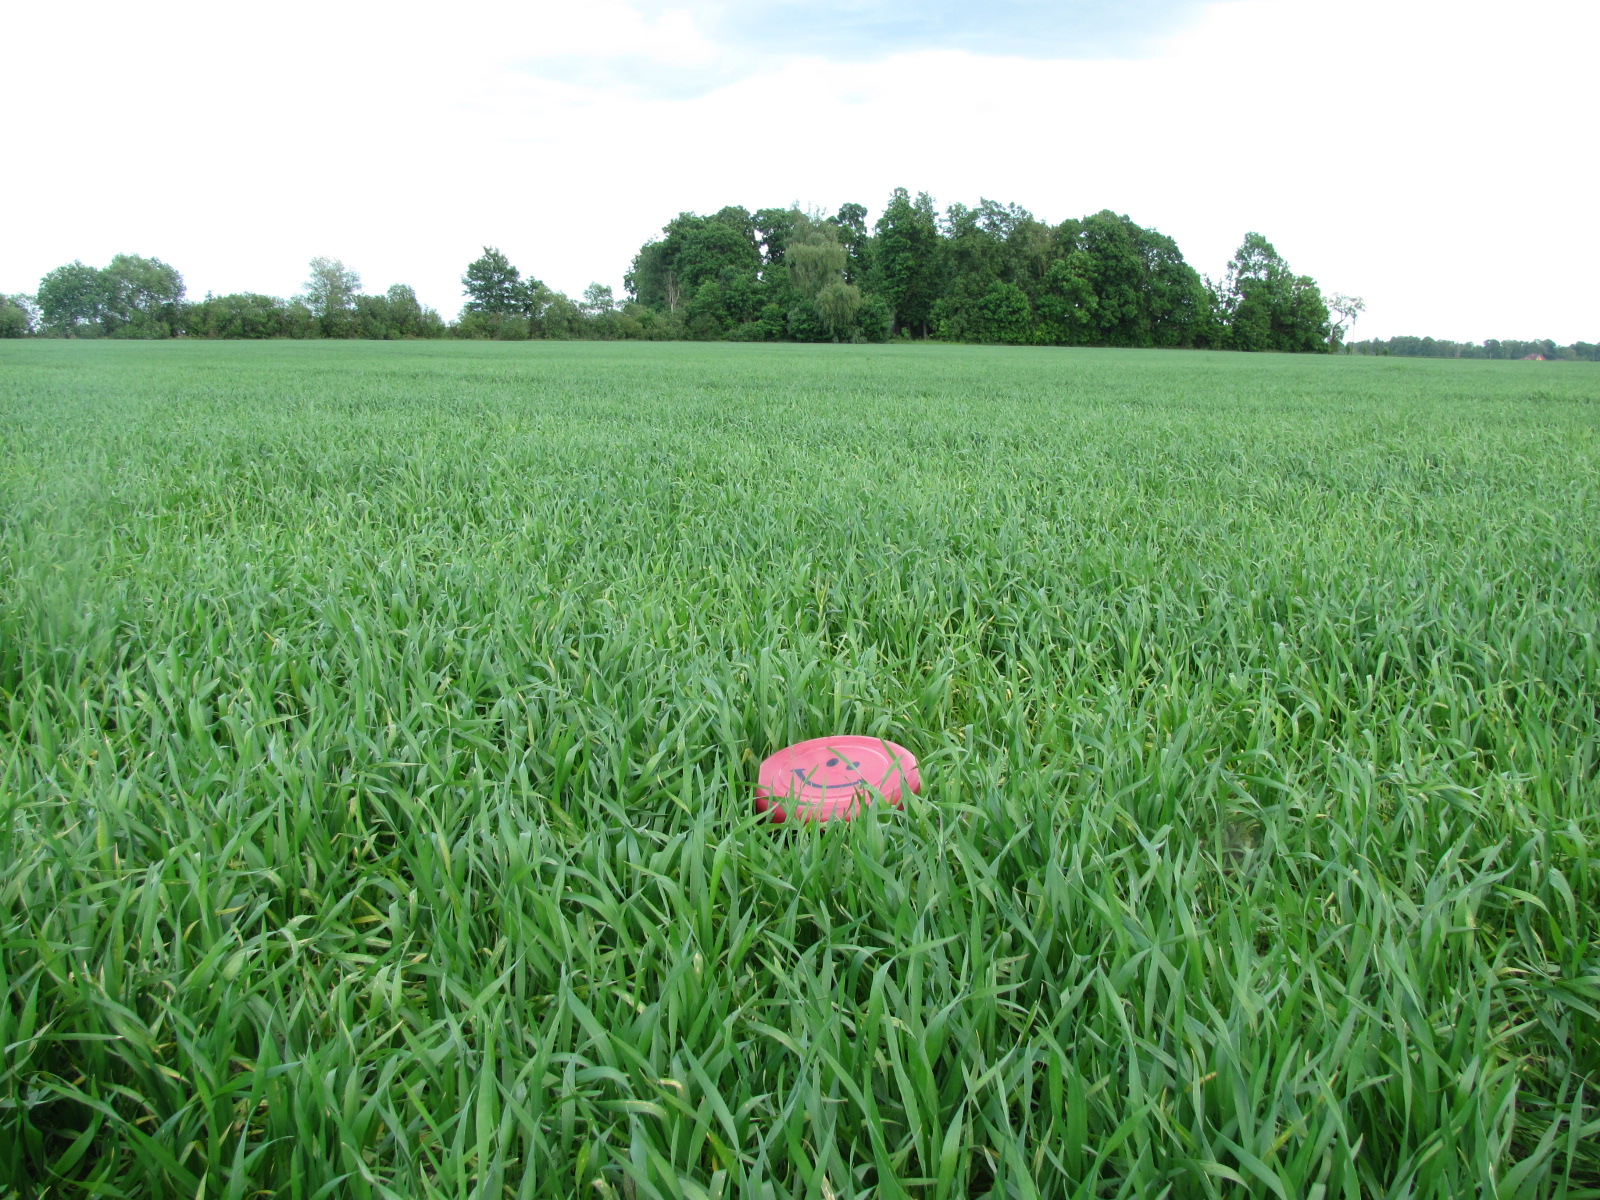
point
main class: Cropland
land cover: Common wheat
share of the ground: > 75 %
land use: Agriculture (excluding fallow land and kitchen gardens)
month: June
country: LV
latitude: 56.3772
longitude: 24.2270
